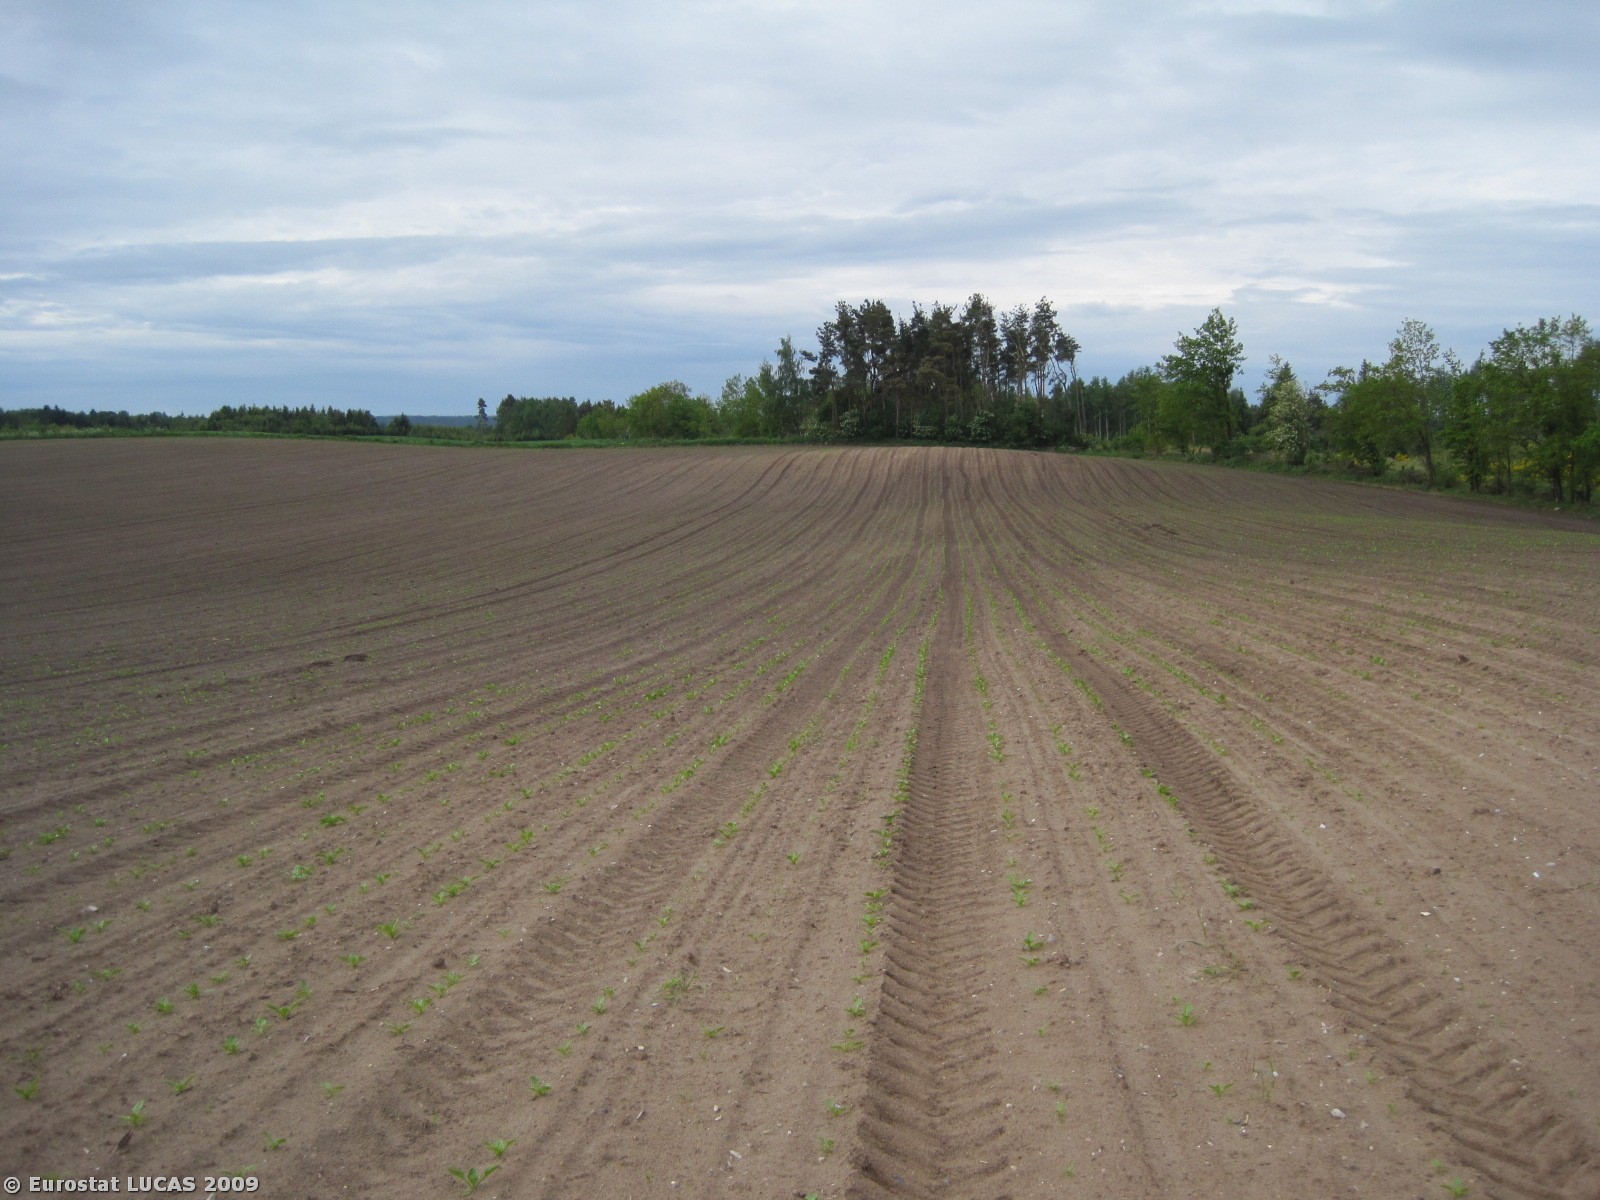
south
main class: Cropland
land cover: Sugar beet
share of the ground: < 10 %
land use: Agriculture (excluding fallow land and kitchen gardens)
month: May
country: DK
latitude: 56.7090
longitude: 10.0163
